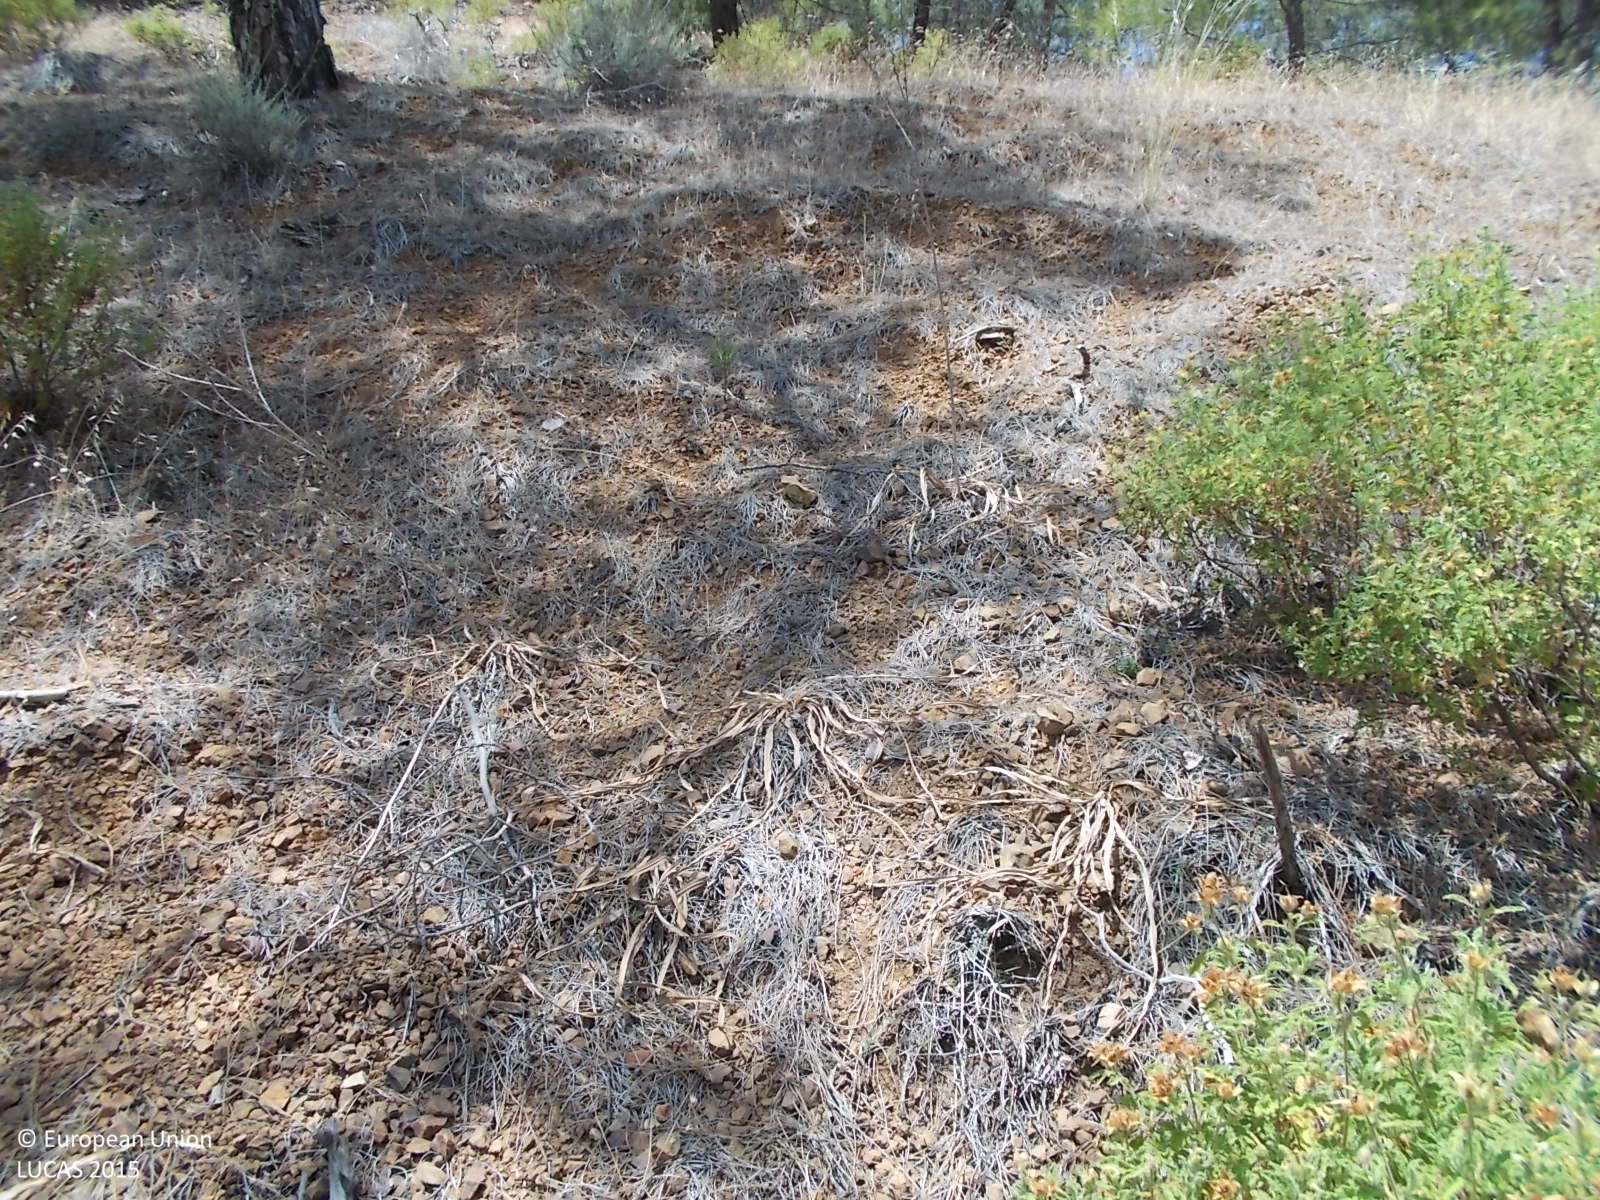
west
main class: Woodland
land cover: Pine dominated coniferous woodland
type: coniferous forest of the mediterranean region
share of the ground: 50 - 75 %
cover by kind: coniferous forest trees 60 %, unconsolidated bare surface 20 %, shrubs 10 %, herbaceous plants 5 %, consolidated bare surface 5 %
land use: Semi-natural and natural areas not in use
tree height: > 5 m
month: June
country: CY
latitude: 35.1317
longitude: 32.6285
